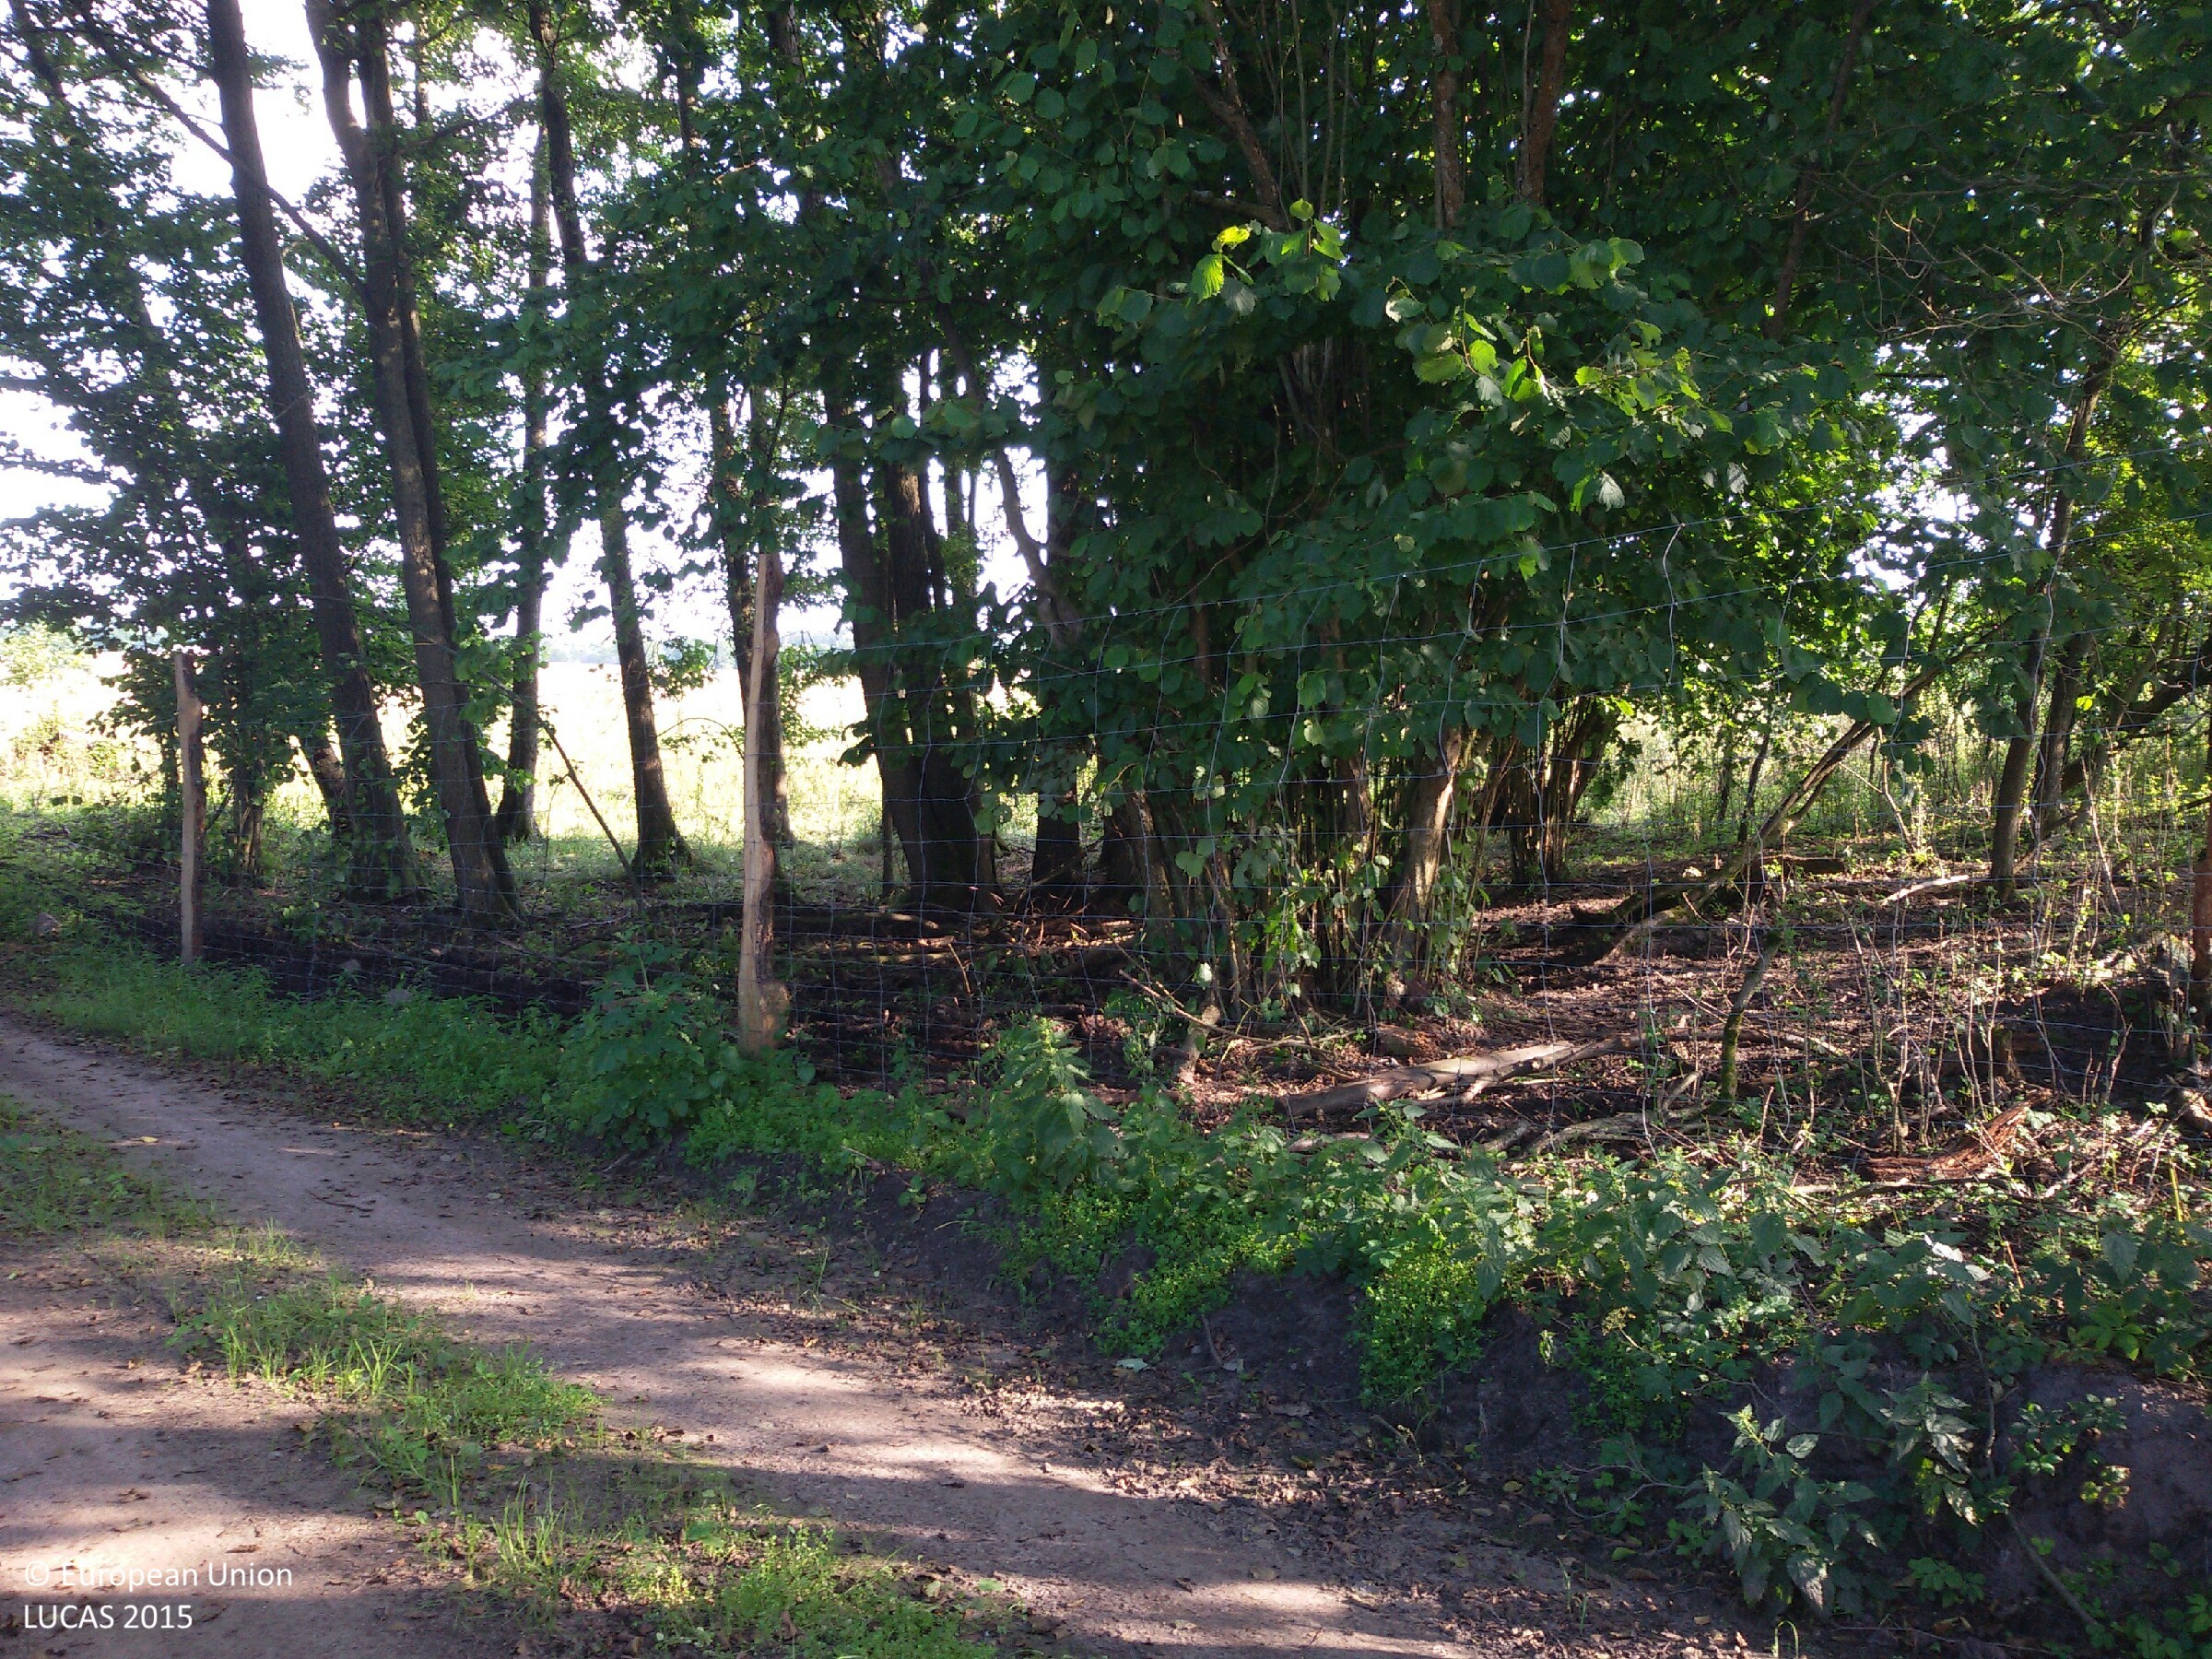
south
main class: Cropland
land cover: Triticale
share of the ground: > 75 %
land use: Agriculture (excluding fallow land and kitchen gardens)
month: July
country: PL
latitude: 53.2312
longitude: 15.7118
